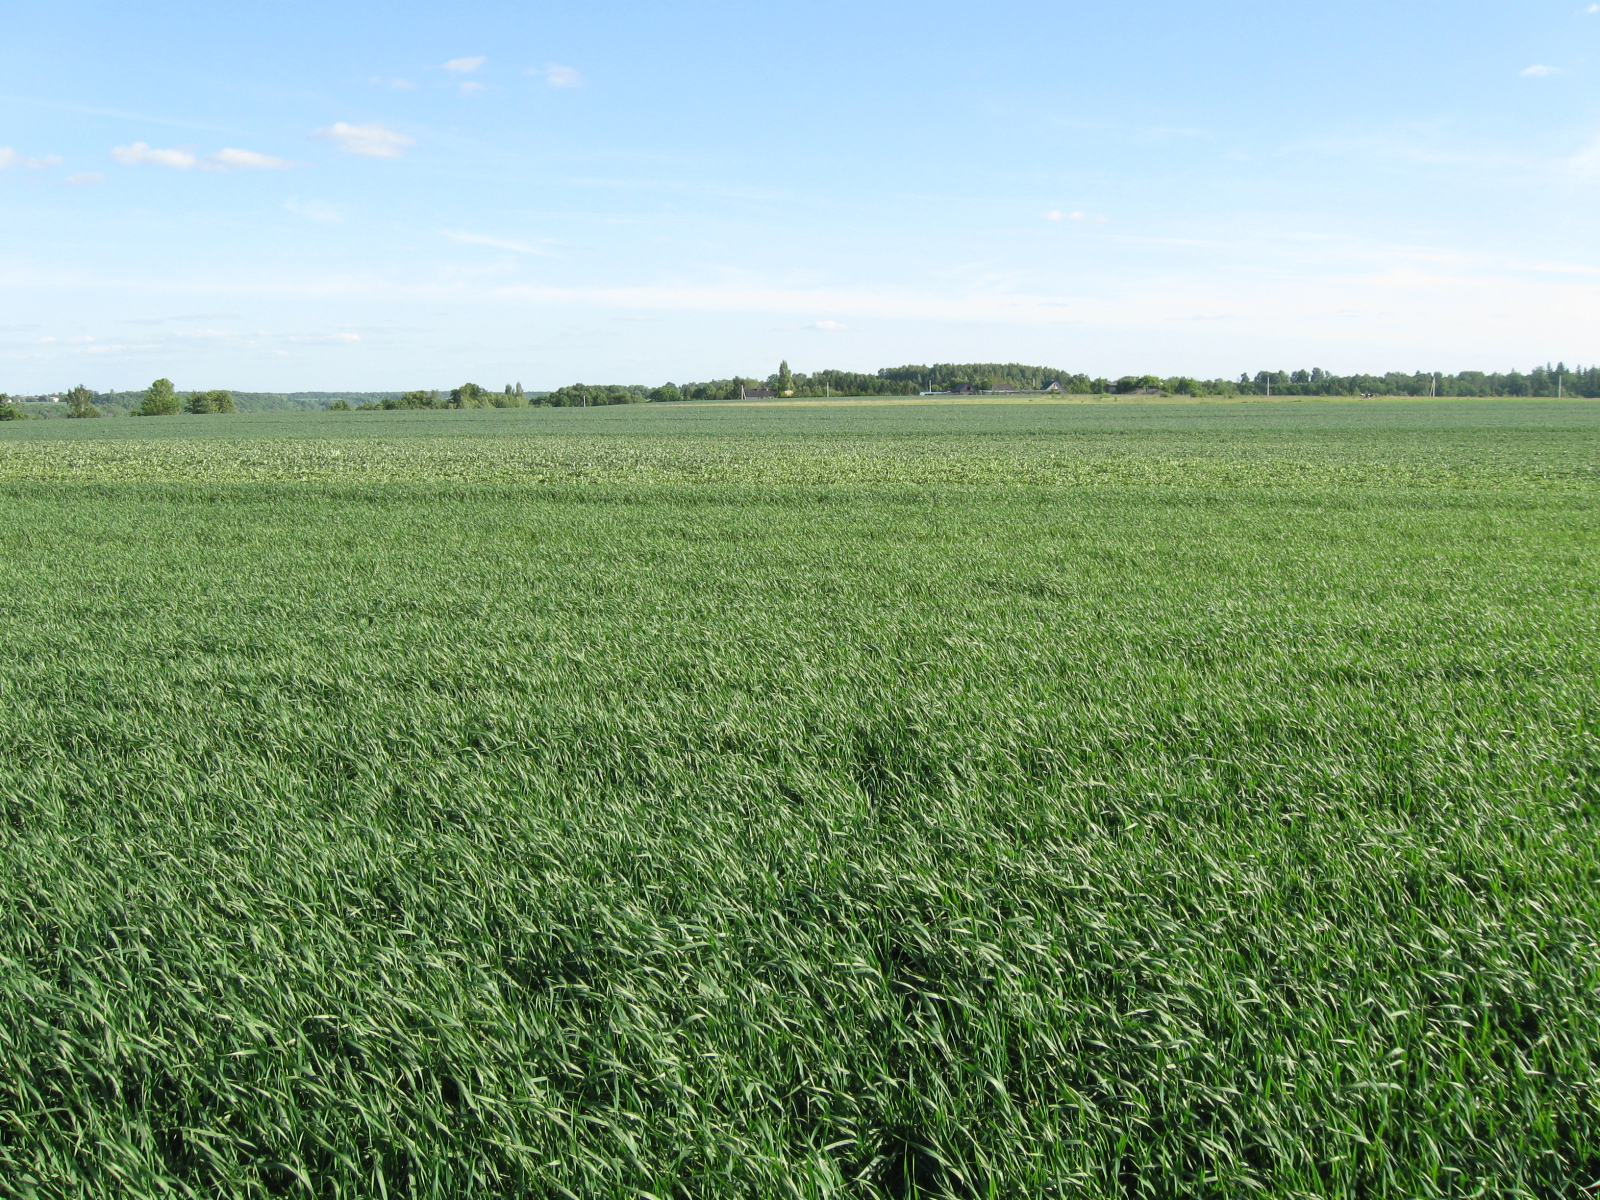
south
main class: Cropland
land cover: Common wheat
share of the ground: > 75 %
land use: Agriculture (excluding fallow land and kitchen gardens)
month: June
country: LT
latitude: 55.0553
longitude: 23.7839
